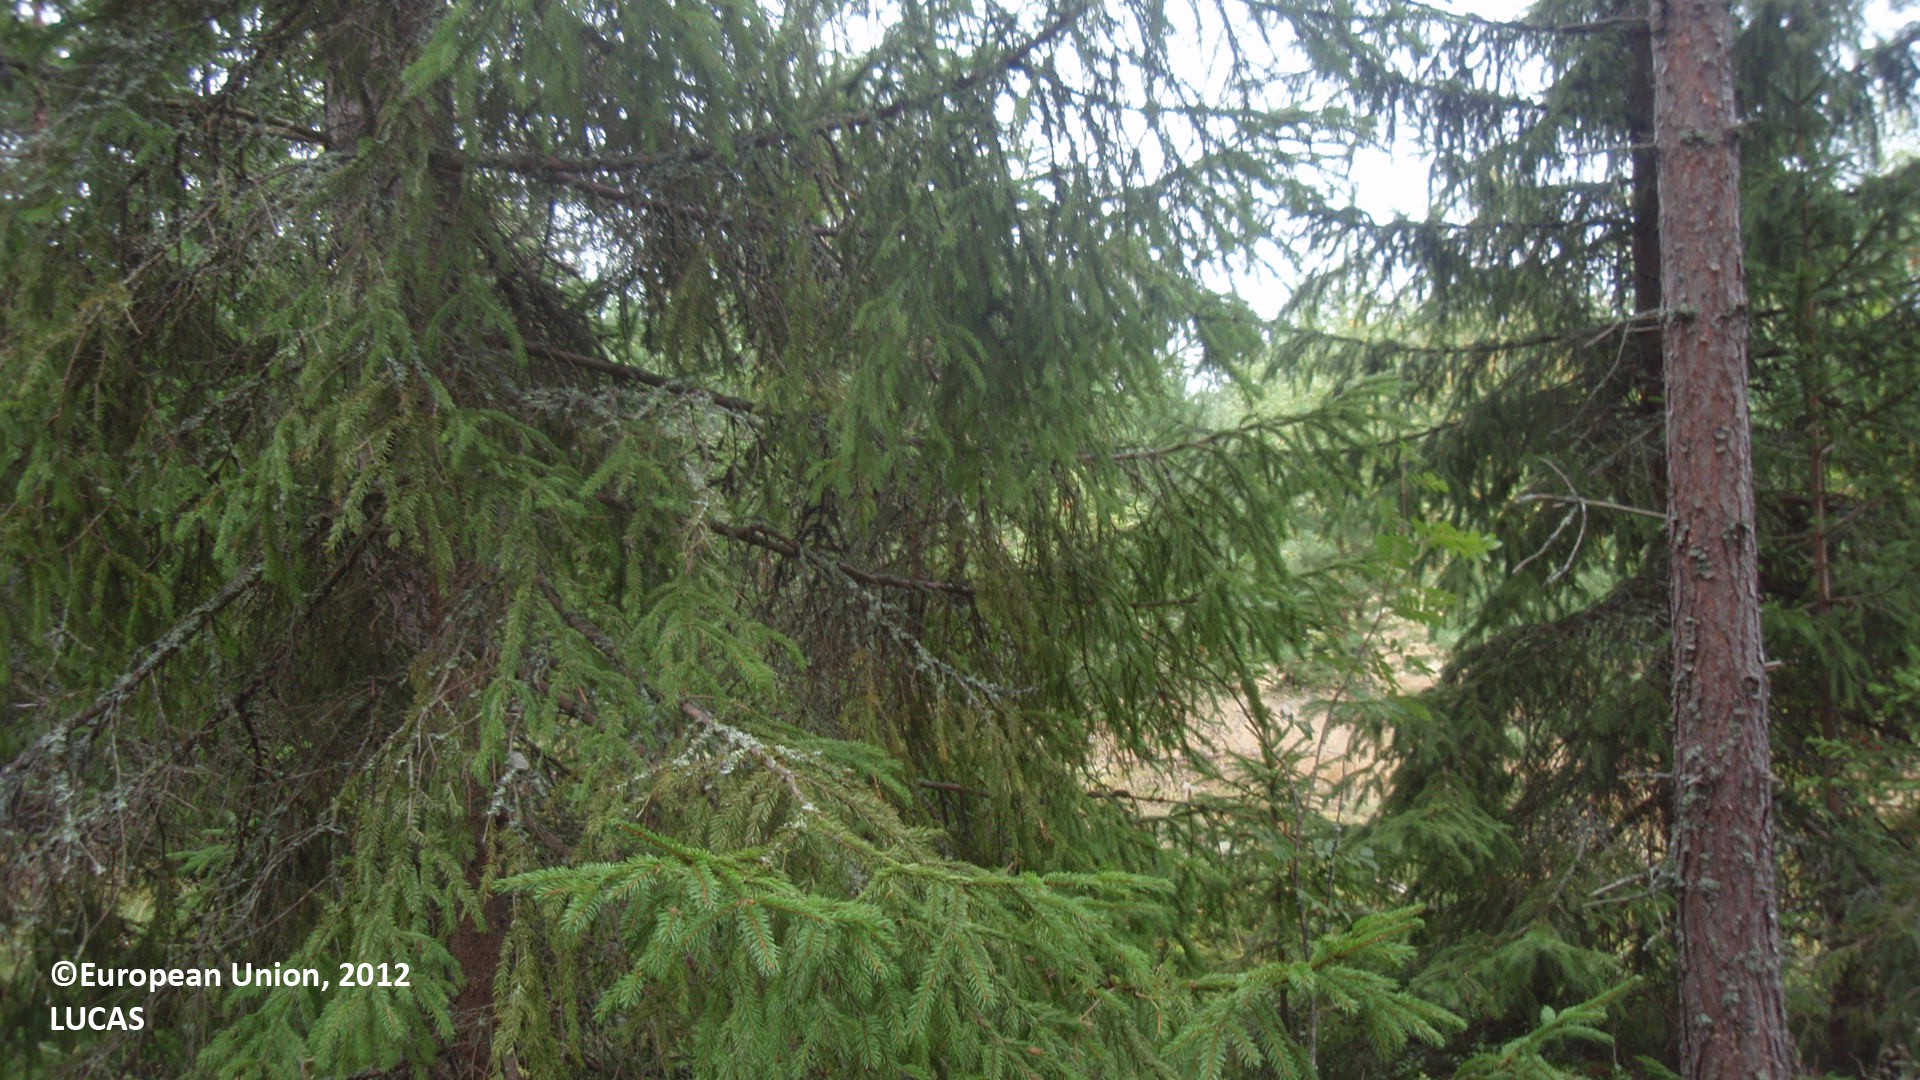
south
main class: Woodland
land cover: Other coniferous woodland
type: boreal forest
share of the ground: 50 - 75 %
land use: Forestry
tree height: > 5 m
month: August
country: FI
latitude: 60.5809
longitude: 26.8281
